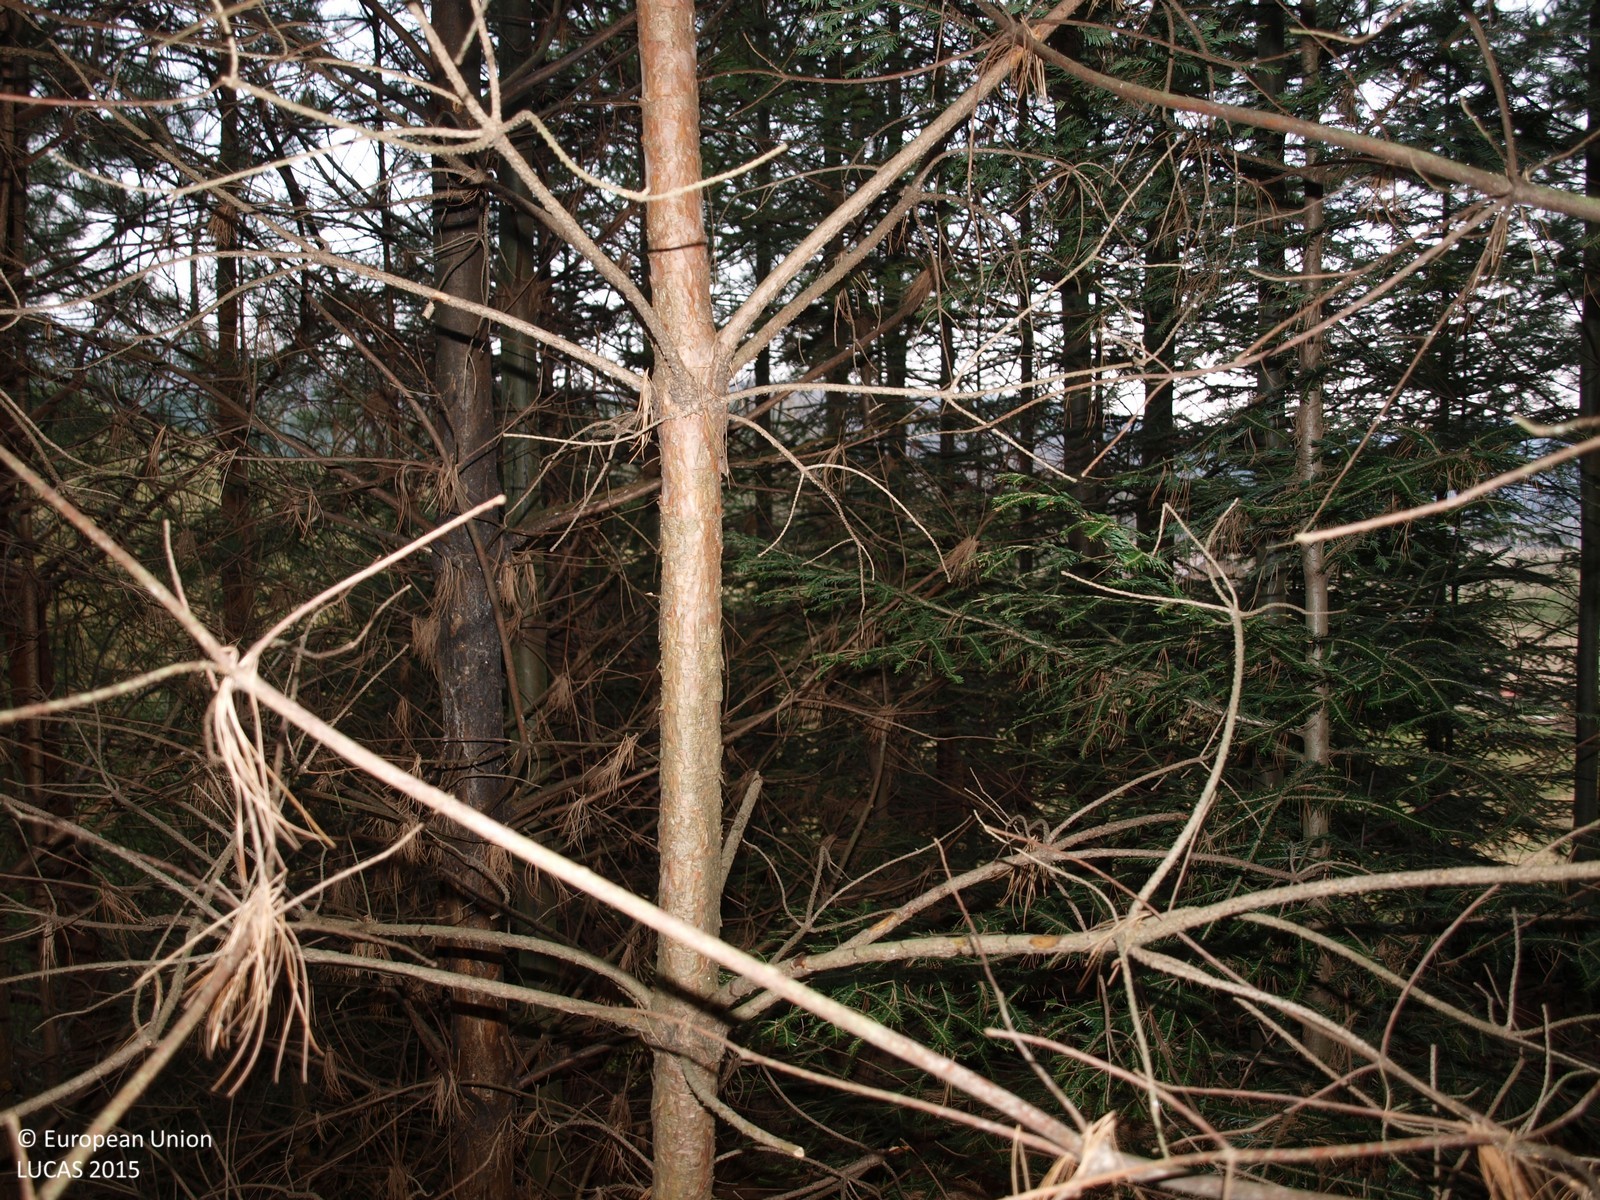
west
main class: Woodland
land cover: Spruce dominated coniferous woodland
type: hemiboreal forest and nemoral coniferous forest and mixed broadleaved-coniferous forest
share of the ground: > 75 %
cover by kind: coniferous forest trees 90 %, shrubs 5 %, herbaceous plants 5 %
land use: Forestry
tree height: > 5 m
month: March
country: HR
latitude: 46.2070
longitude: 16.2078
